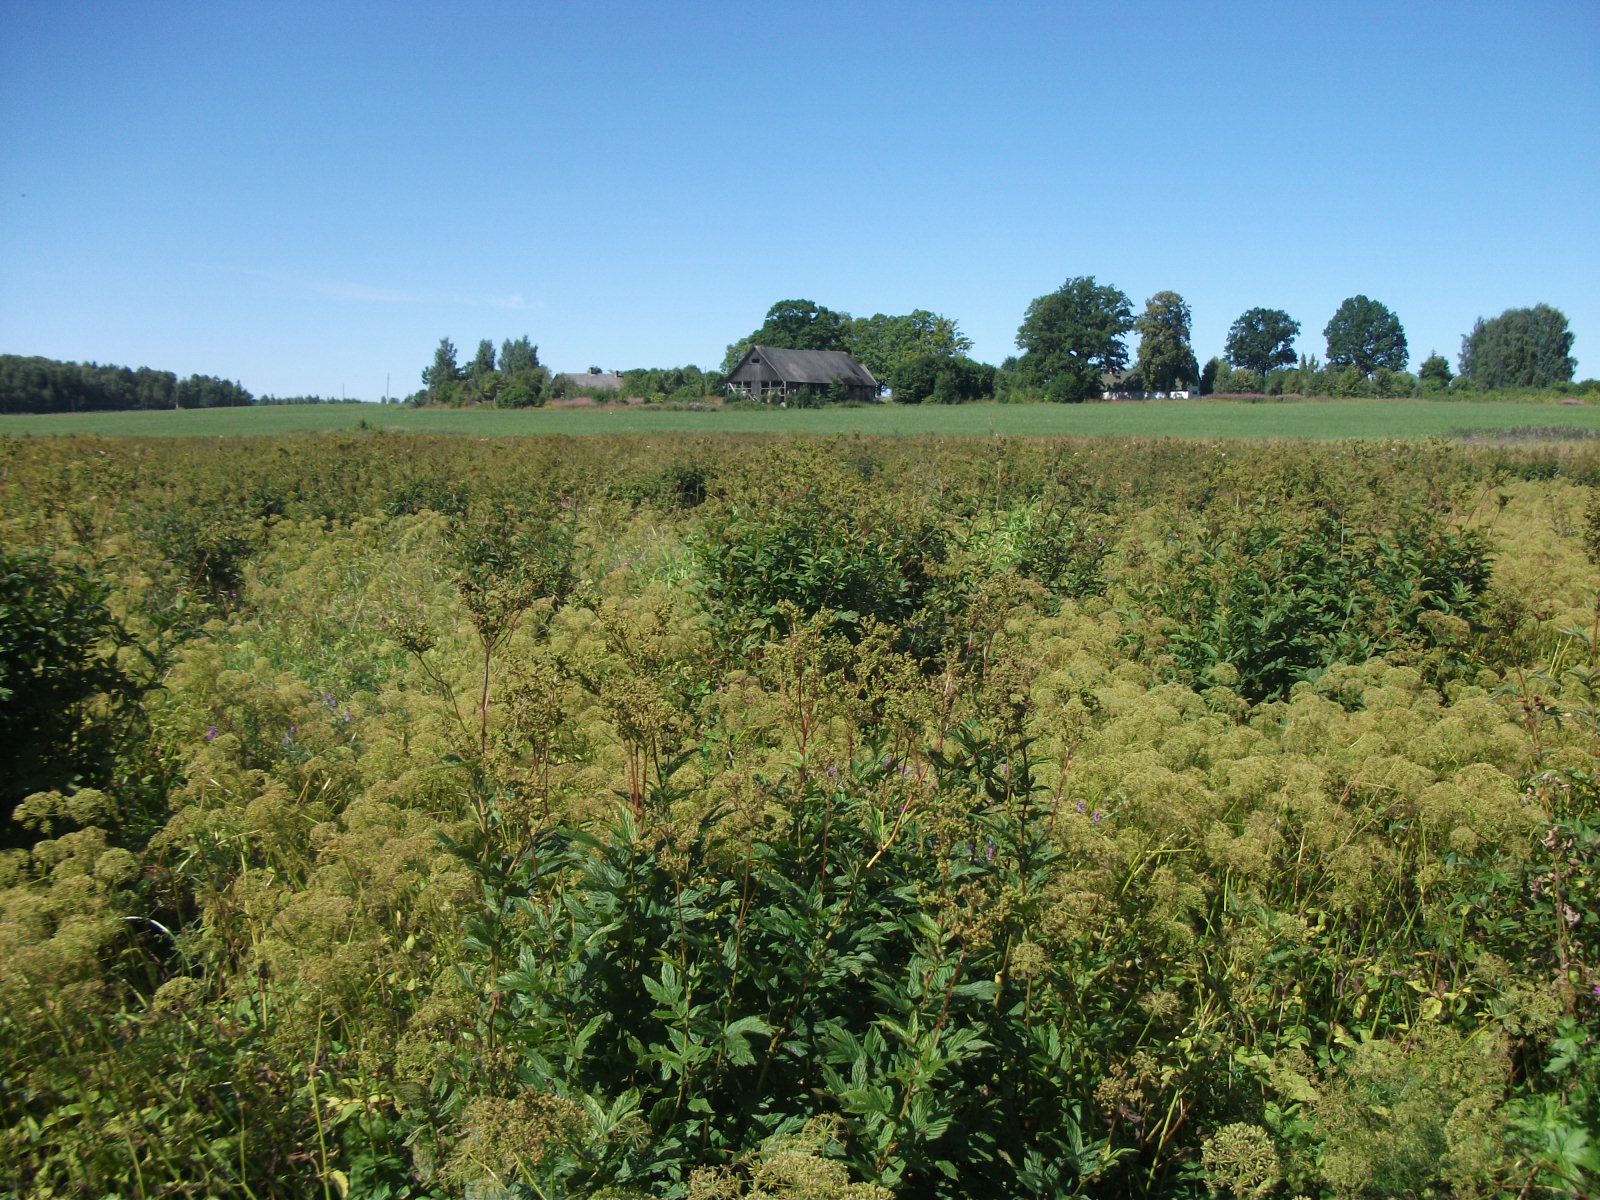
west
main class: Grassland
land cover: Spontaneously vegetated surfaces
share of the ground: > 75 %
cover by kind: herbaceous plants 100 %
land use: Abandoned areas
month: August
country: LV
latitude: 57.0265
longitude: 26.4705
